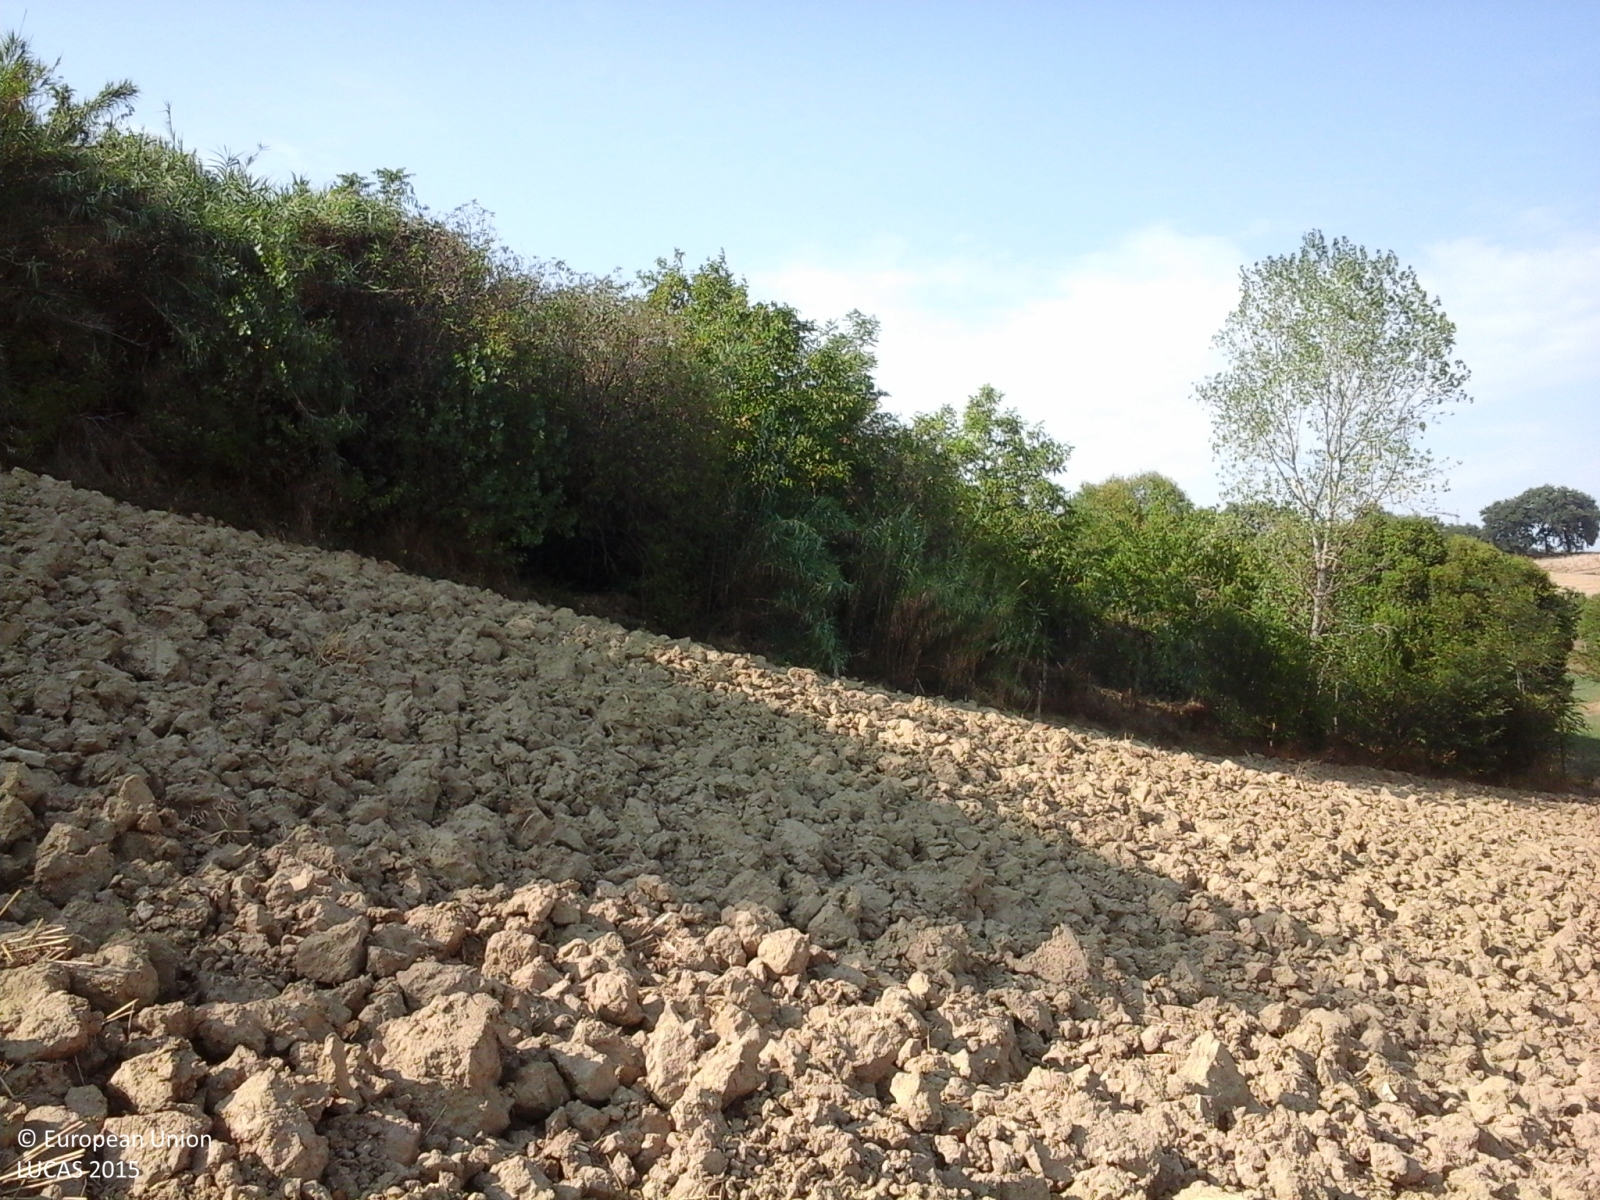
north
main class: Cropland
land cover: Durum wheat
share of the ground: < 10 %
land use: Agriculture (excluding fallow land and kitchen gardens)
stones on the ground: 10 - 25 %
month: August
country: IT
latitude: 43.4466
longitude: 13.3896
